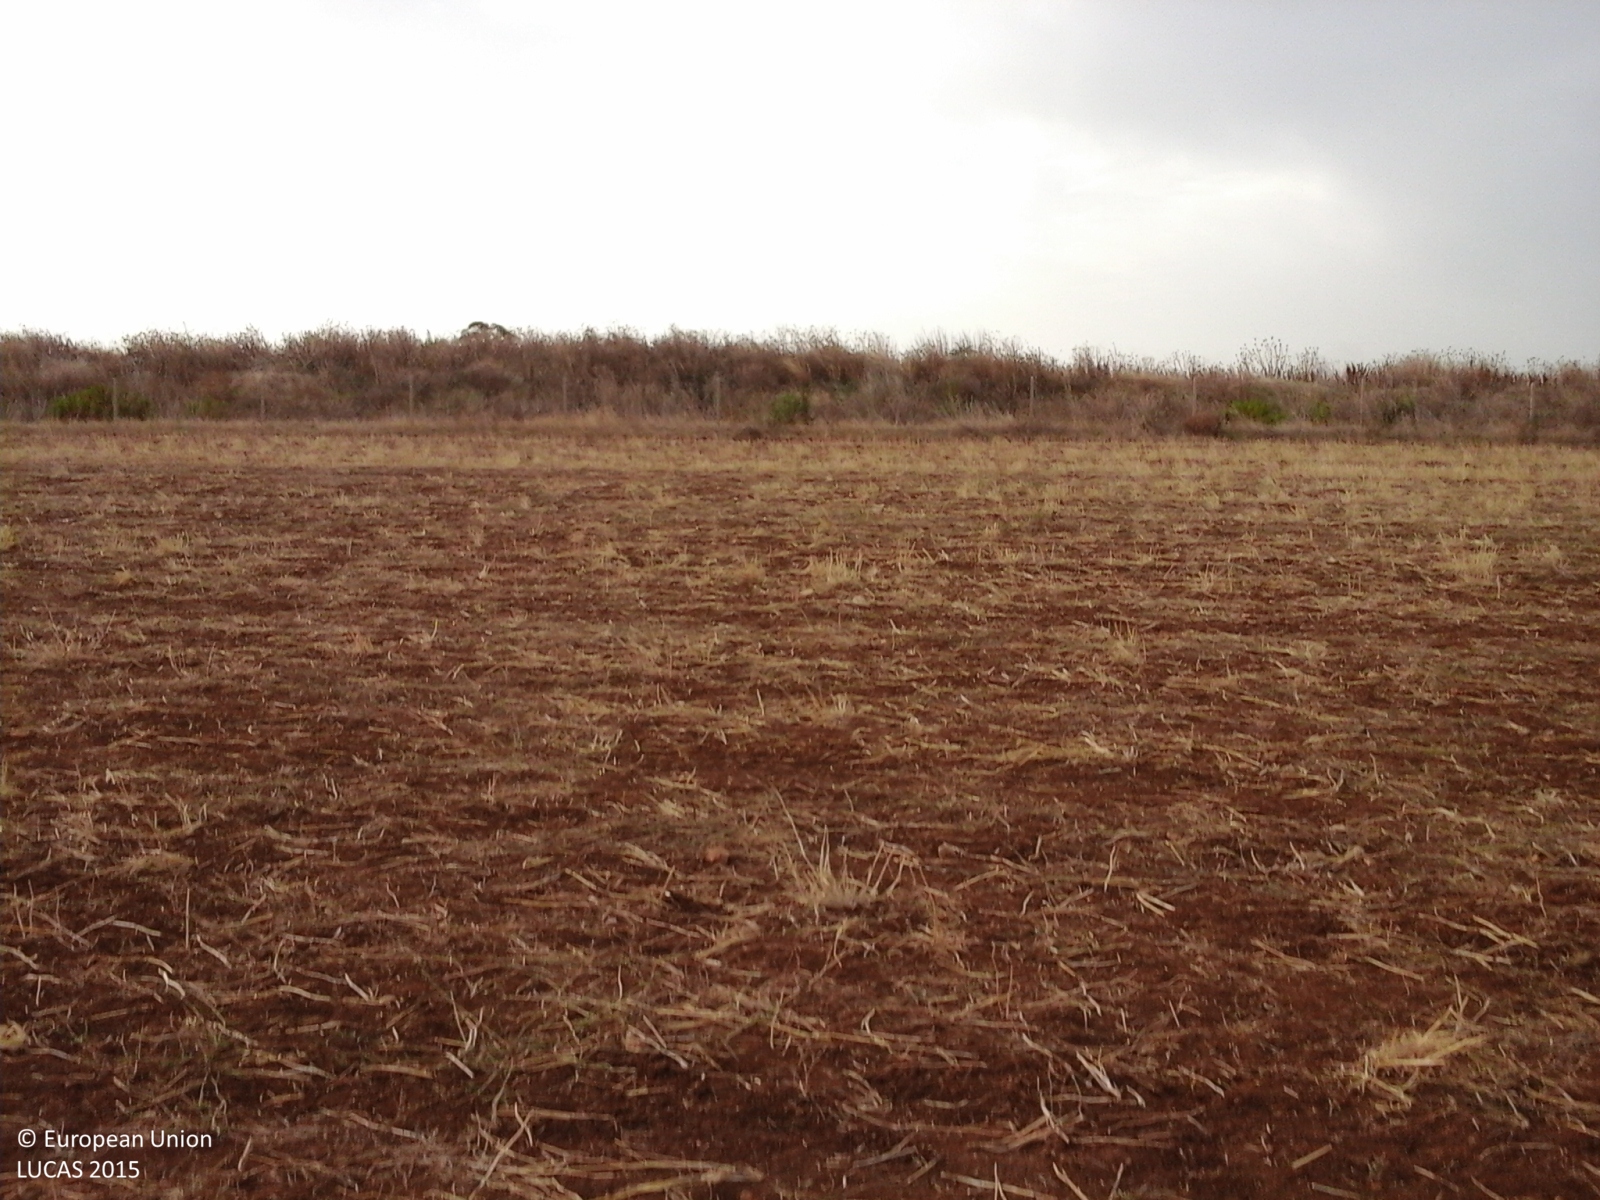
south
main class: Cropland
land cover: Other non-permanent industrial crops
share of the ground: > 75 %
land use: Agriculture (excluding fallow land and kitchen gardens)
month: September
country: IT
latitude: 41.8881
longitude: 15.1784
